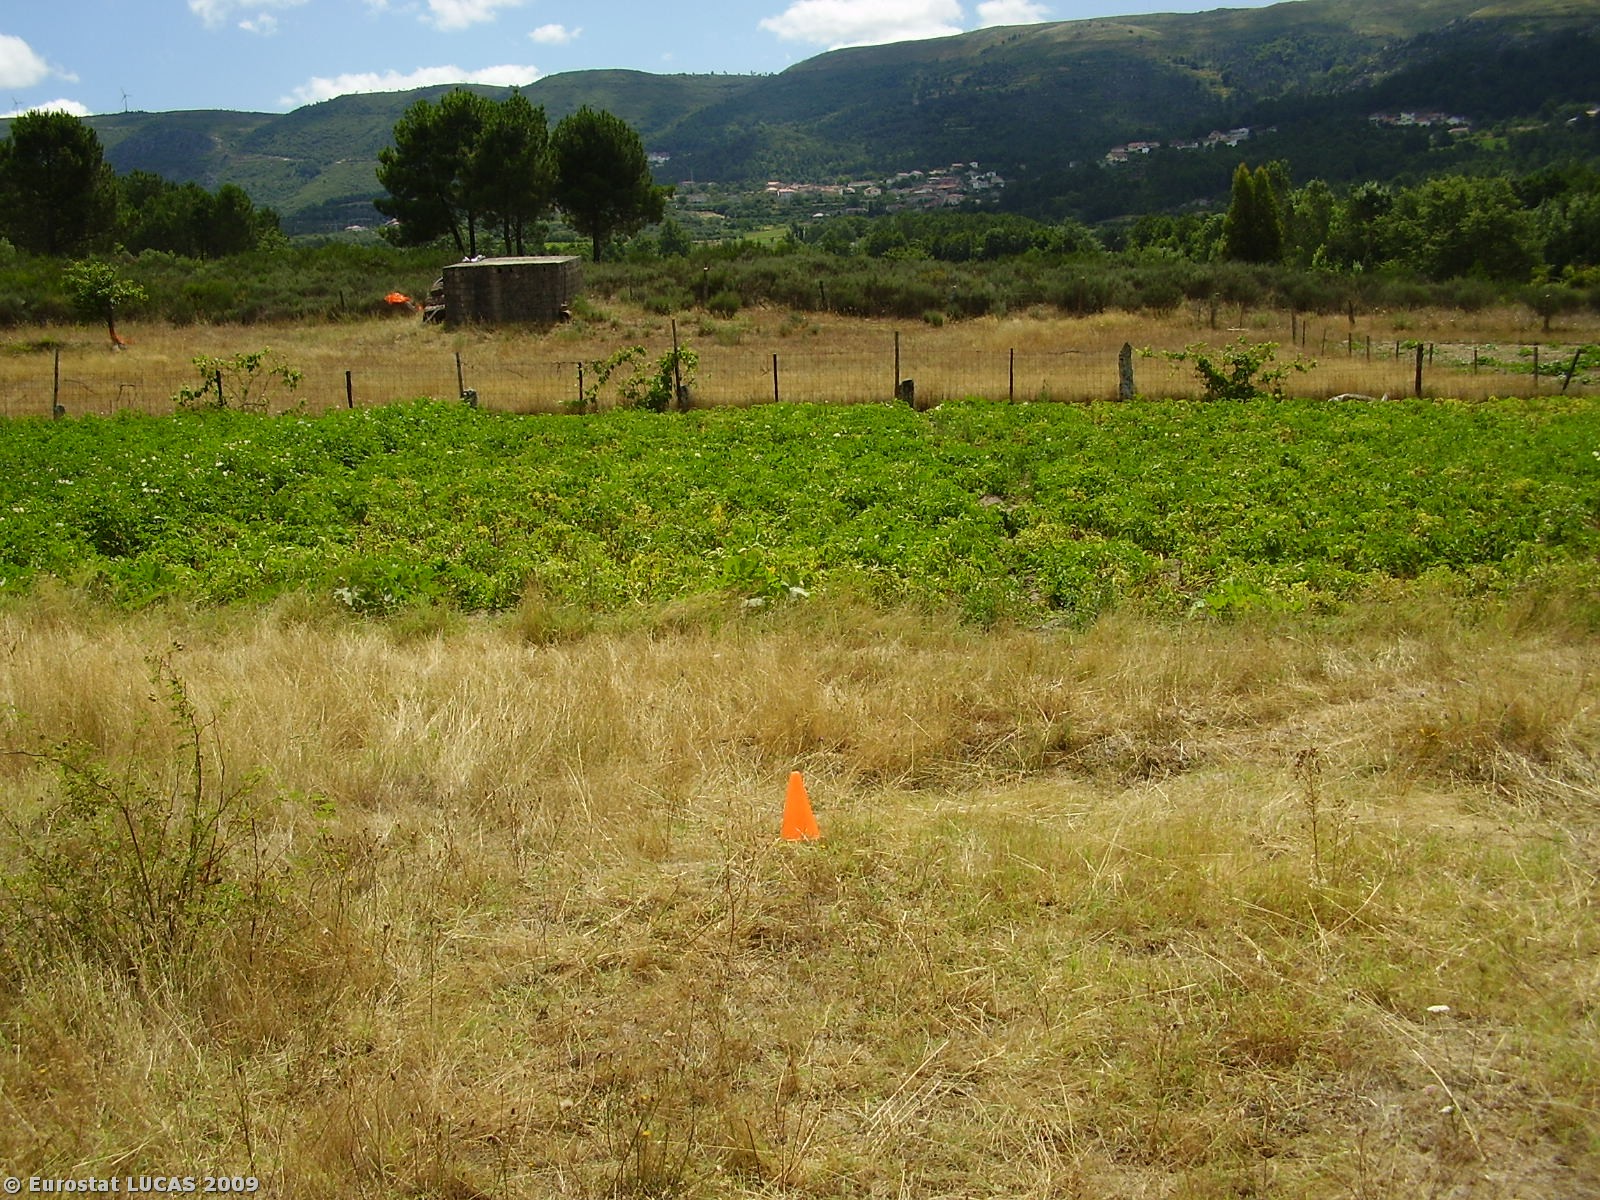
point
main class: Grassland
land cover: Spontaneously vegetated surfaces
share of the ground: > 75 %
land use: Fallow land
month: July
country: PT
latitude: 41.5636
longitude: -7.5775
